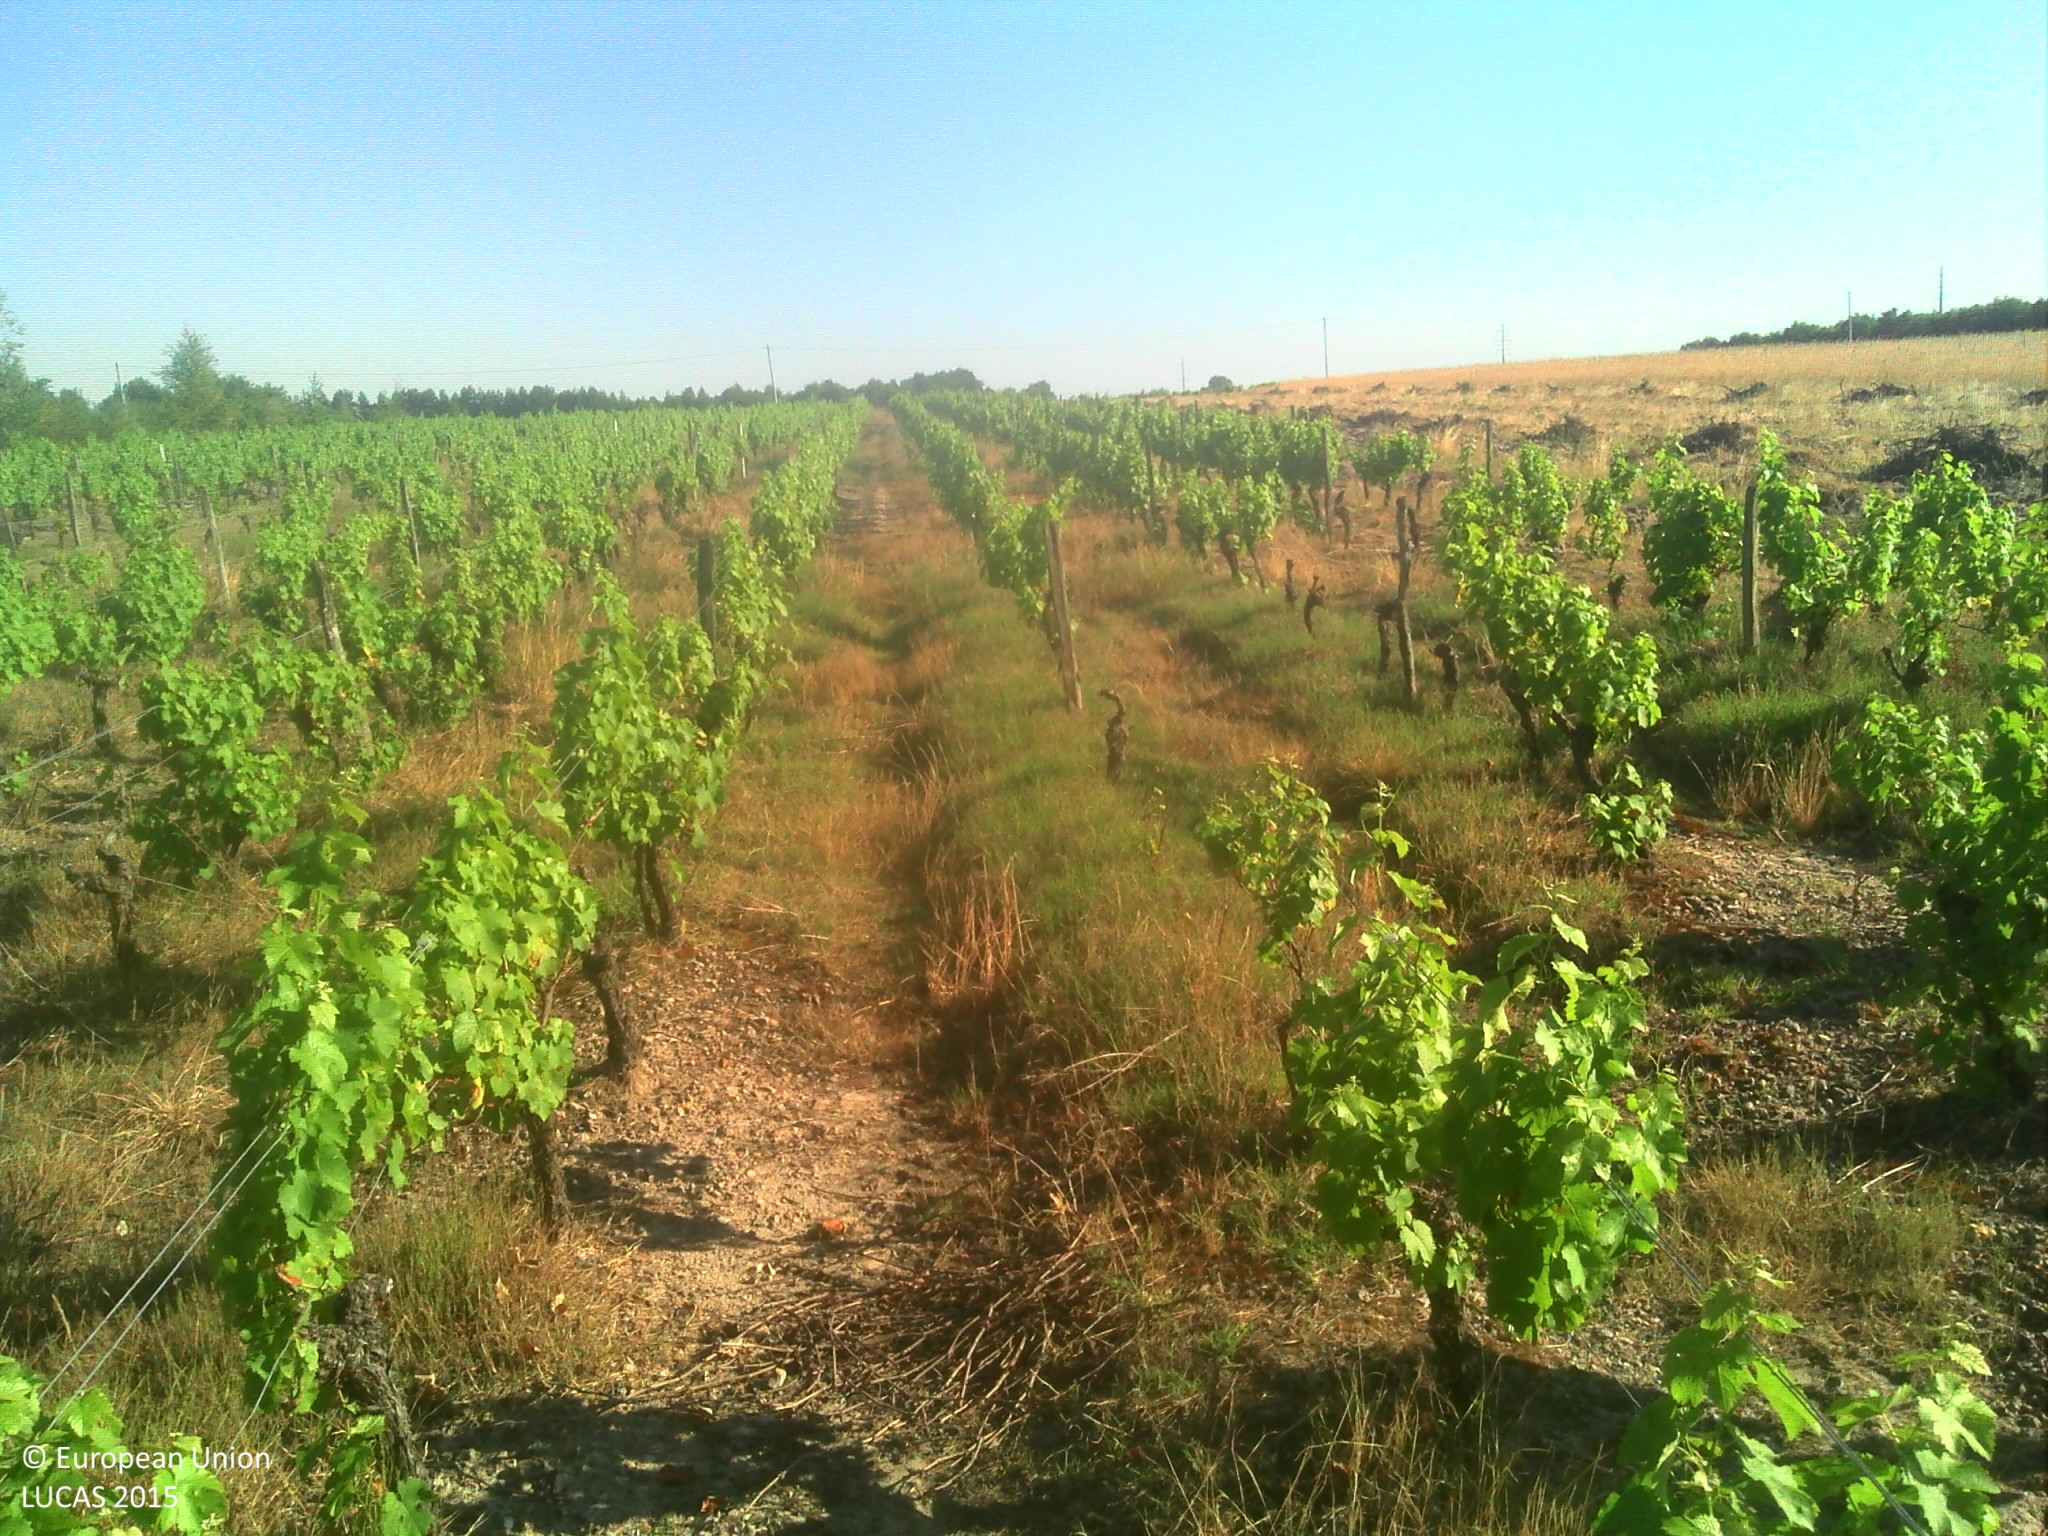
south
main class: Cropland
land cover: Vineyards
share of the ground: 25 - 50 %
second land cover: Spontaneously vegetated surfaces
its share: > 75 %
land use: Agriculture (excluding fallow land and kitchen gardens)
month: June
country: FR
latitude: 47.3342
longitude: 1.5039
